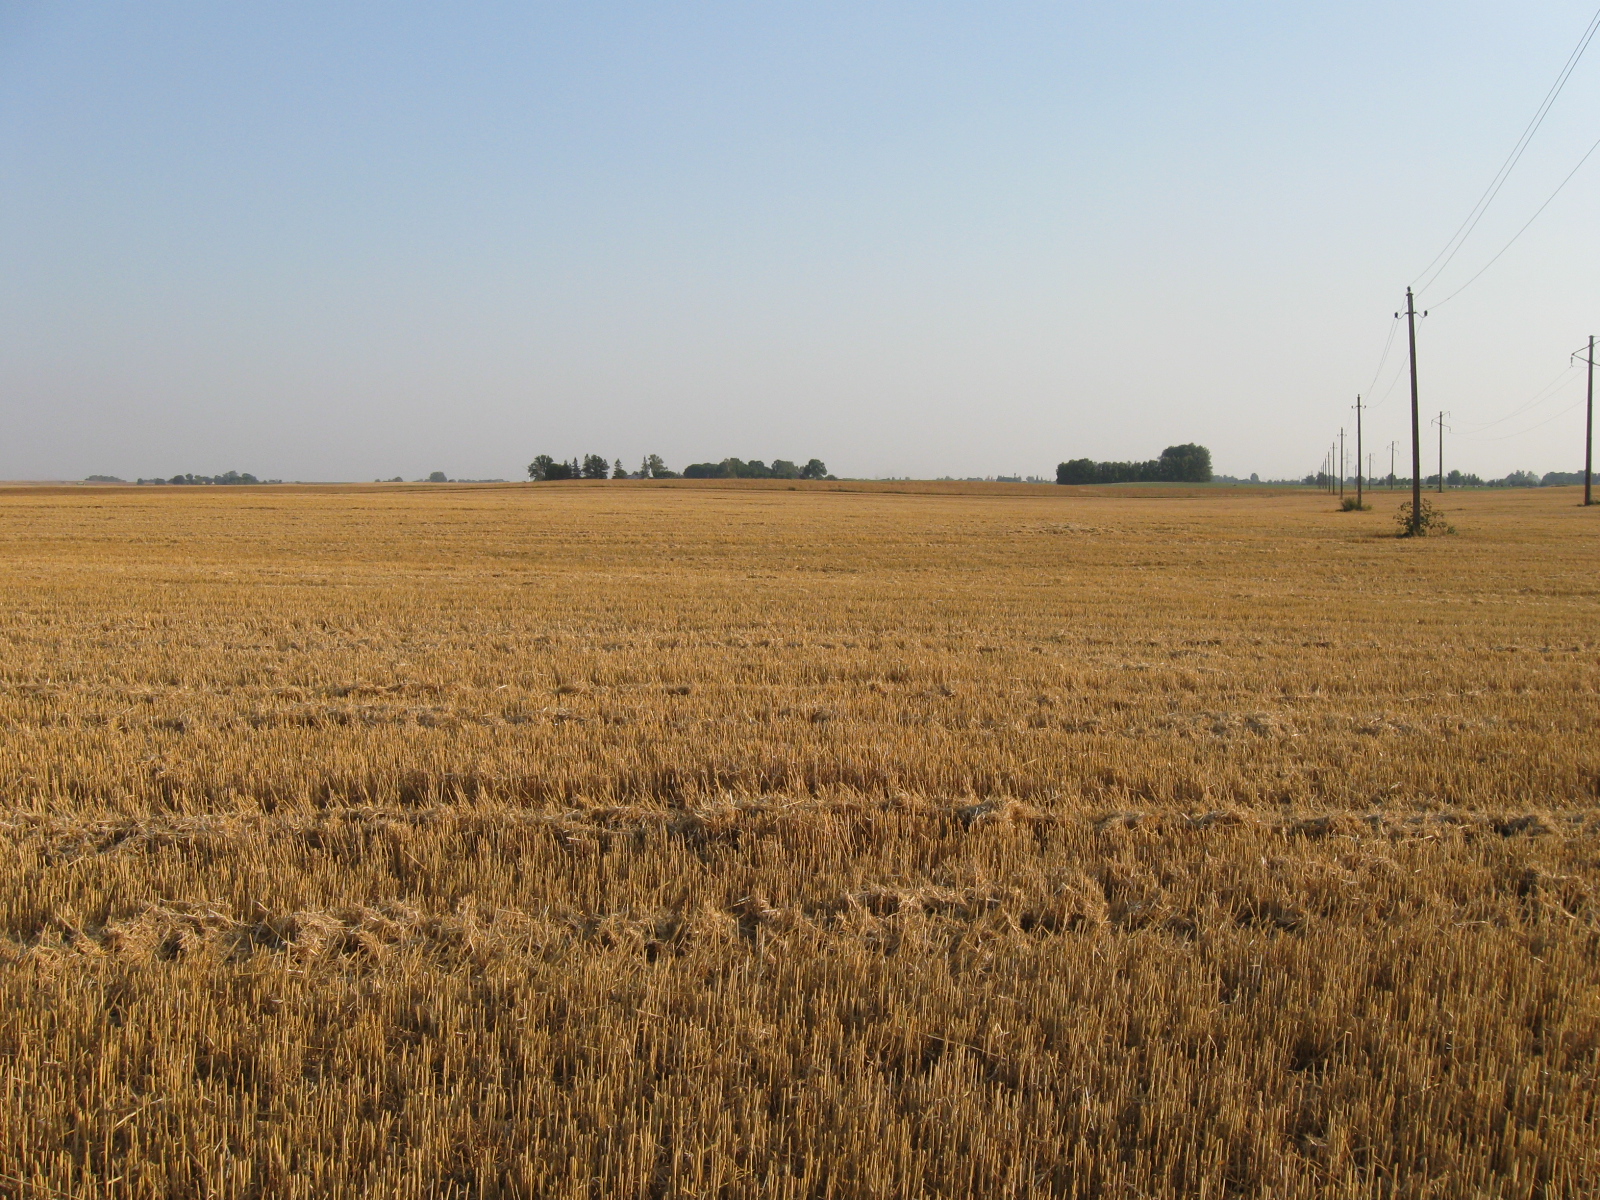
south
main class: Cropland
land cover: Common wheat
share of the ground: < 10 %
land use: Agriculture (excluding fallow land and kitchen gardens)
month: August
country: LT
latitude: 54.4727
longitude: 23.2711
